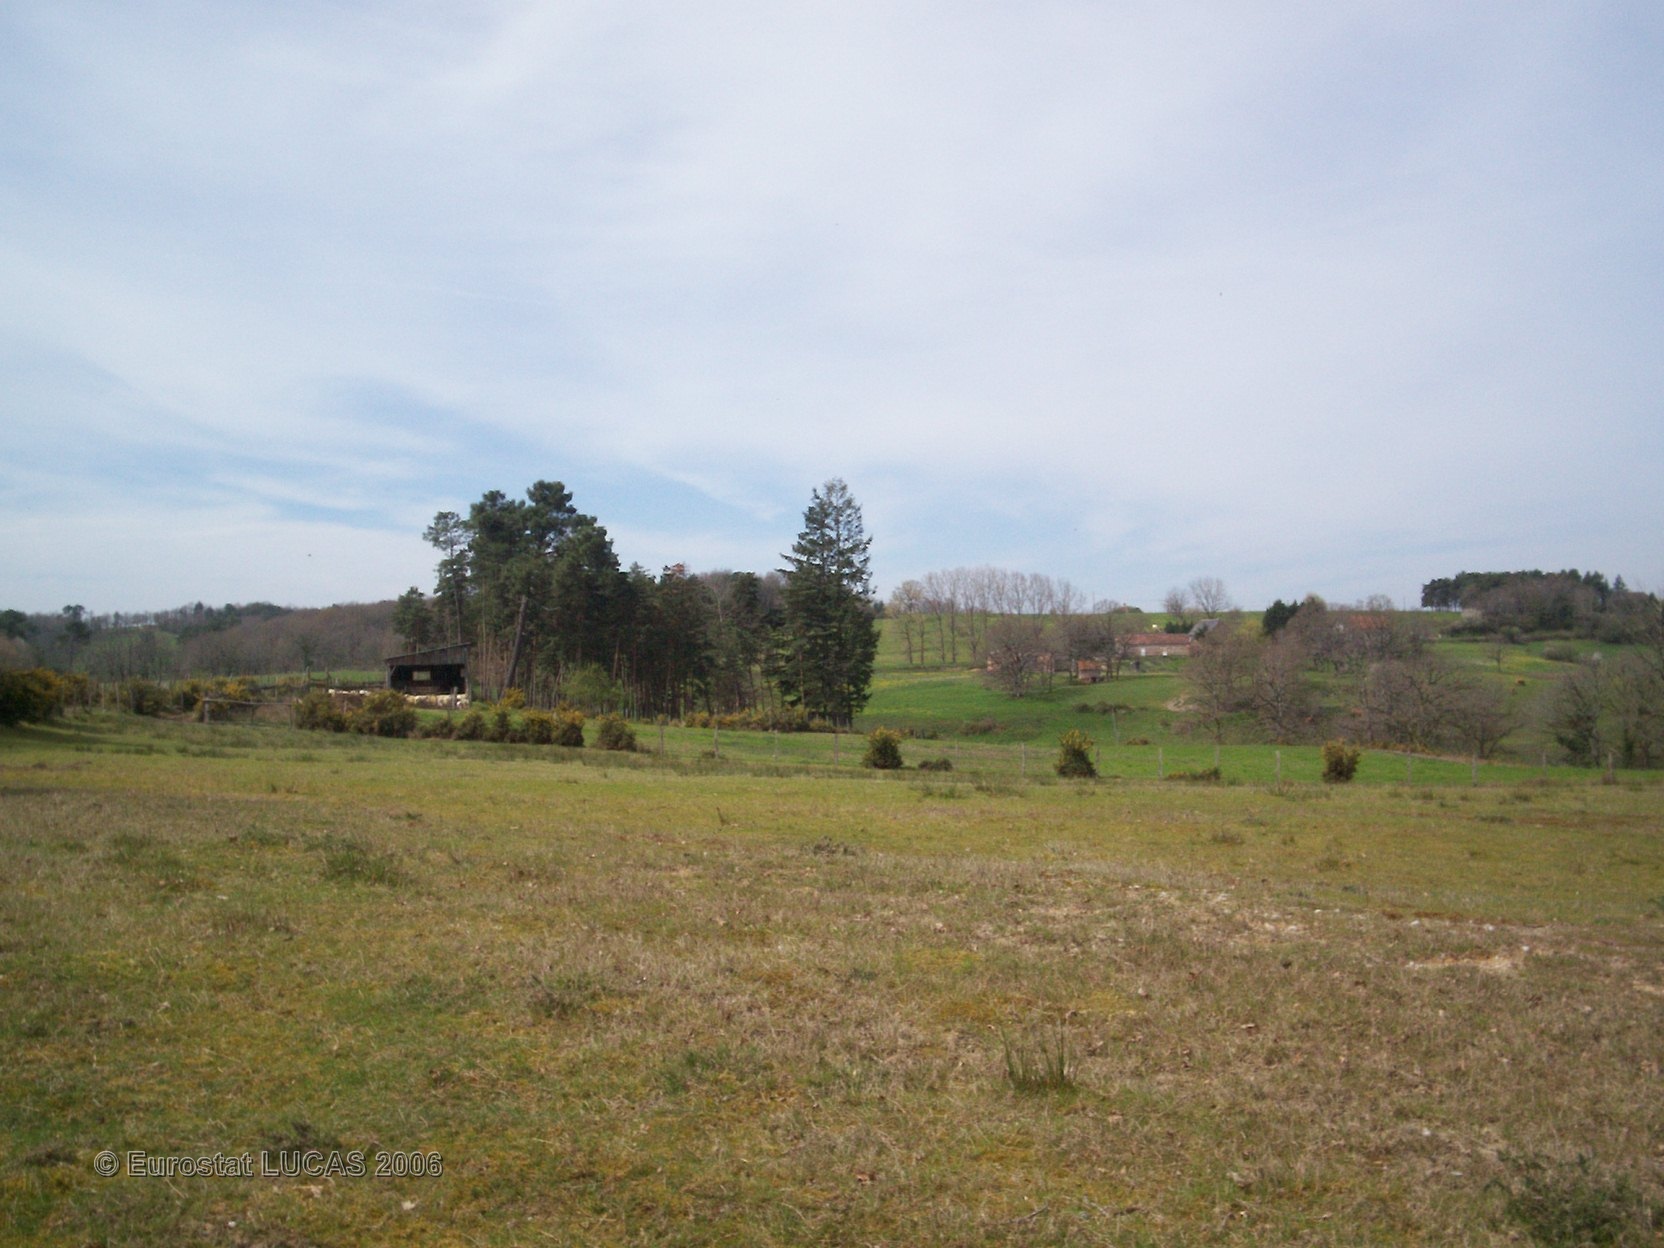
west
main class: Grassland
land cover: Grassland without tree/shrub cover
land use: Agriculture (excluding fallow land and kitchen gardens)
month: April
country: FR
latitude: 45.1811
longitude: 1.3020
